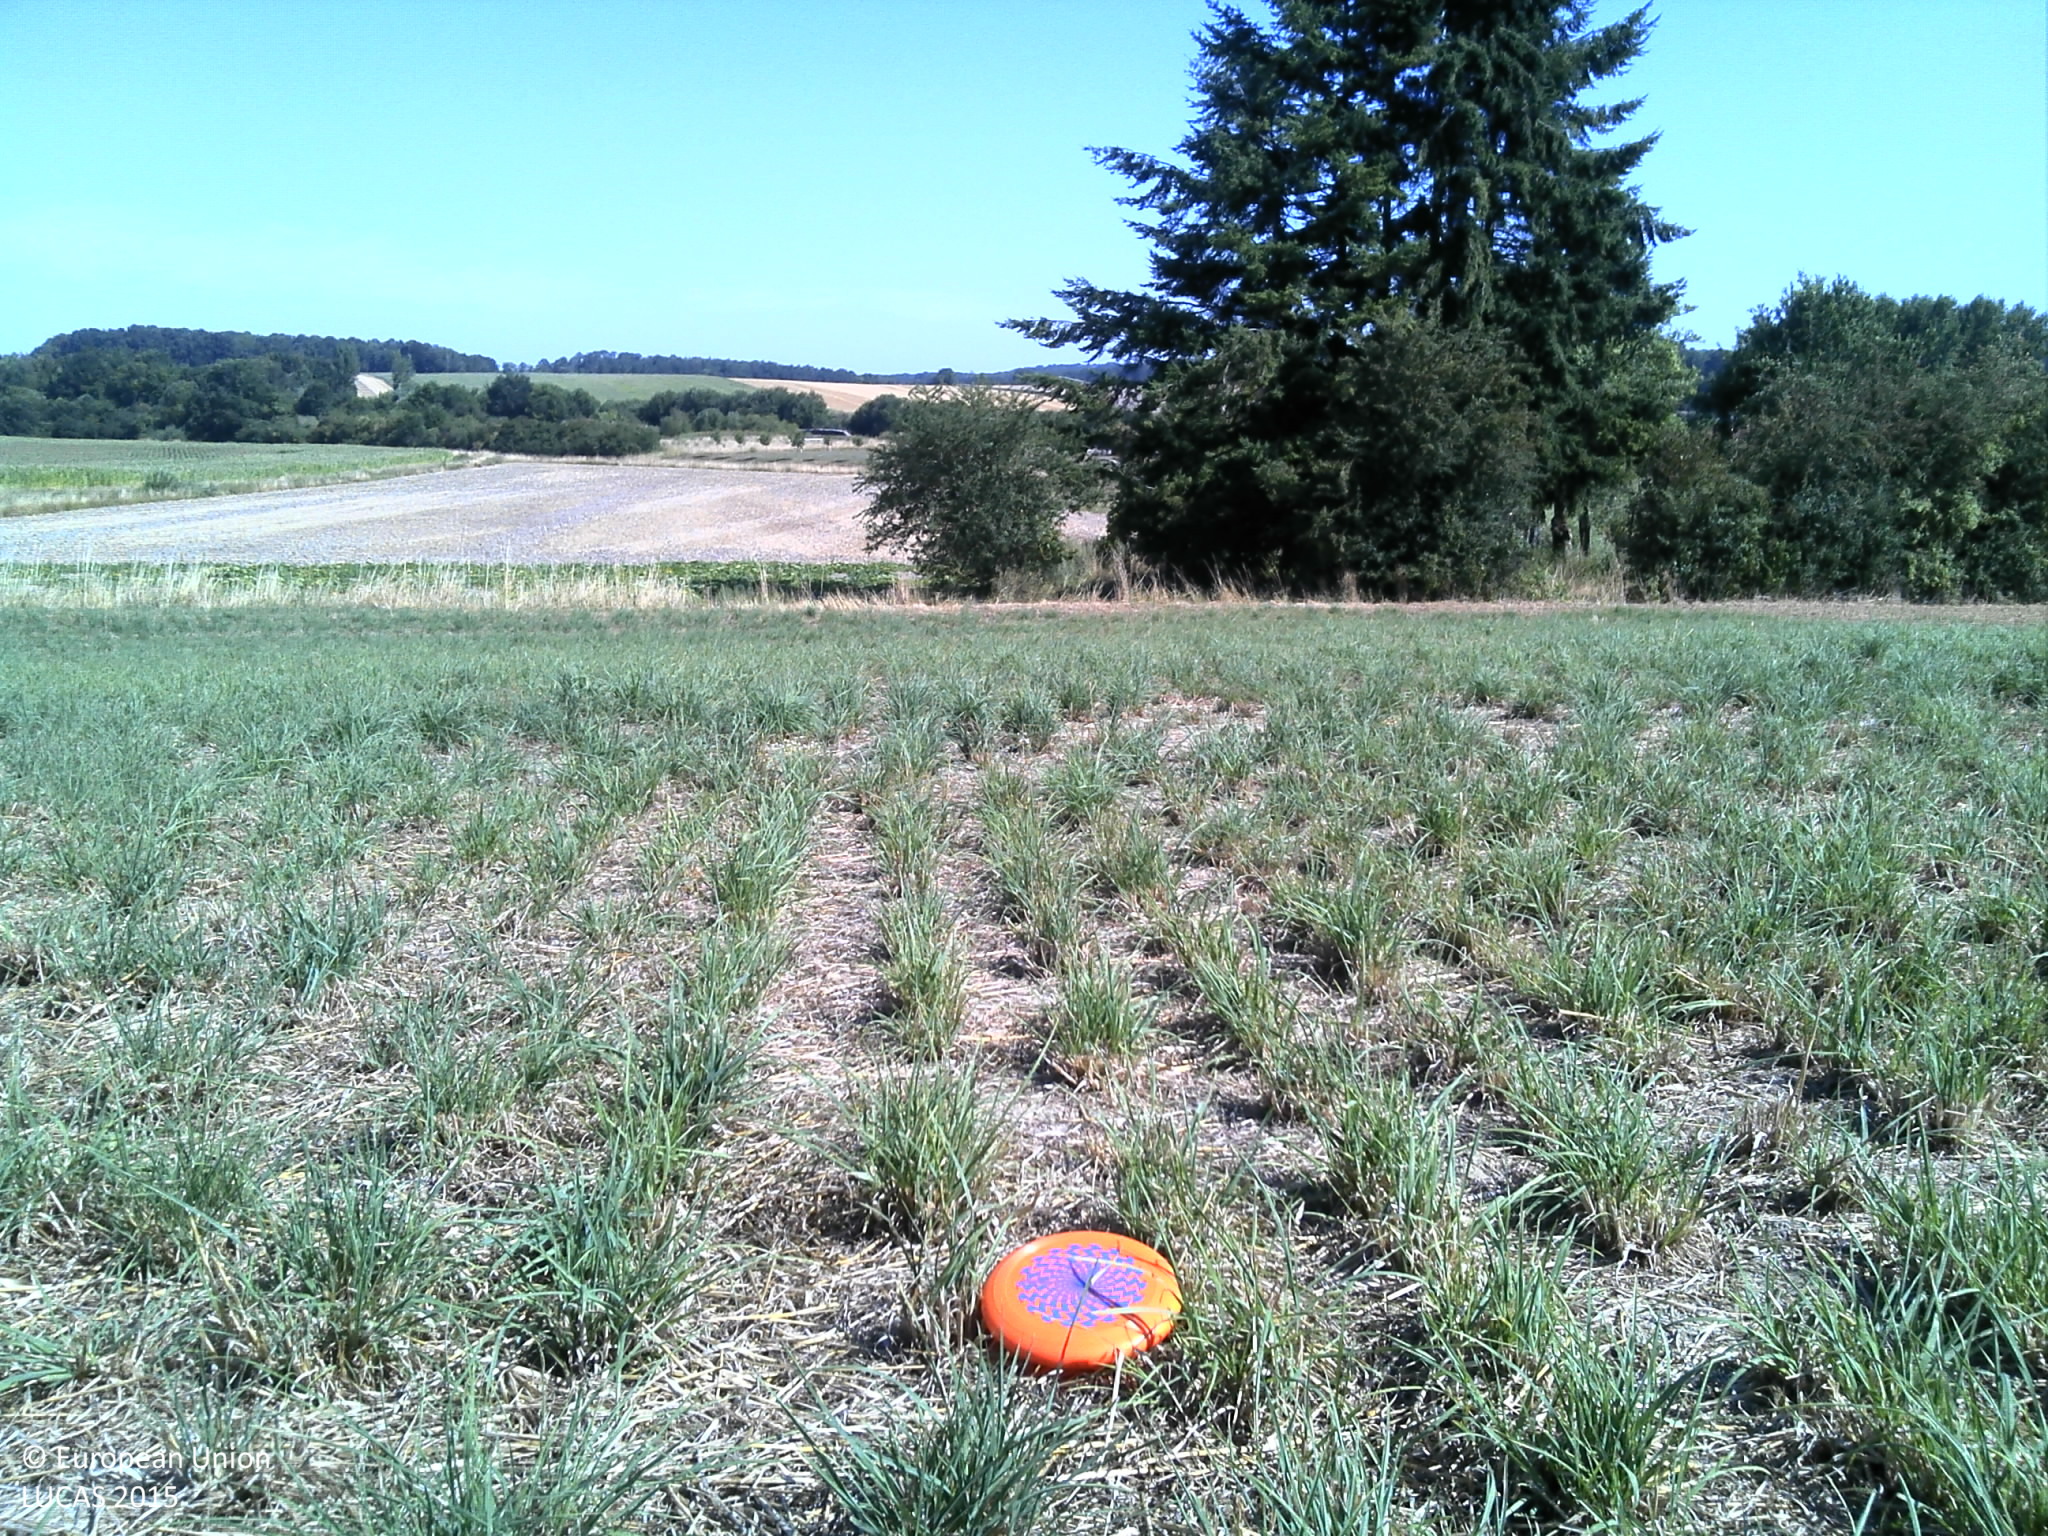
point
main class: Cropland
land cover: Temporary grasslands
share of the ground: > 75 %
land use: Agriculture (excluding fallow land and kitchen gardens)
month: August
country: FR
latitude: 49.1670
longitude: 4.8543
